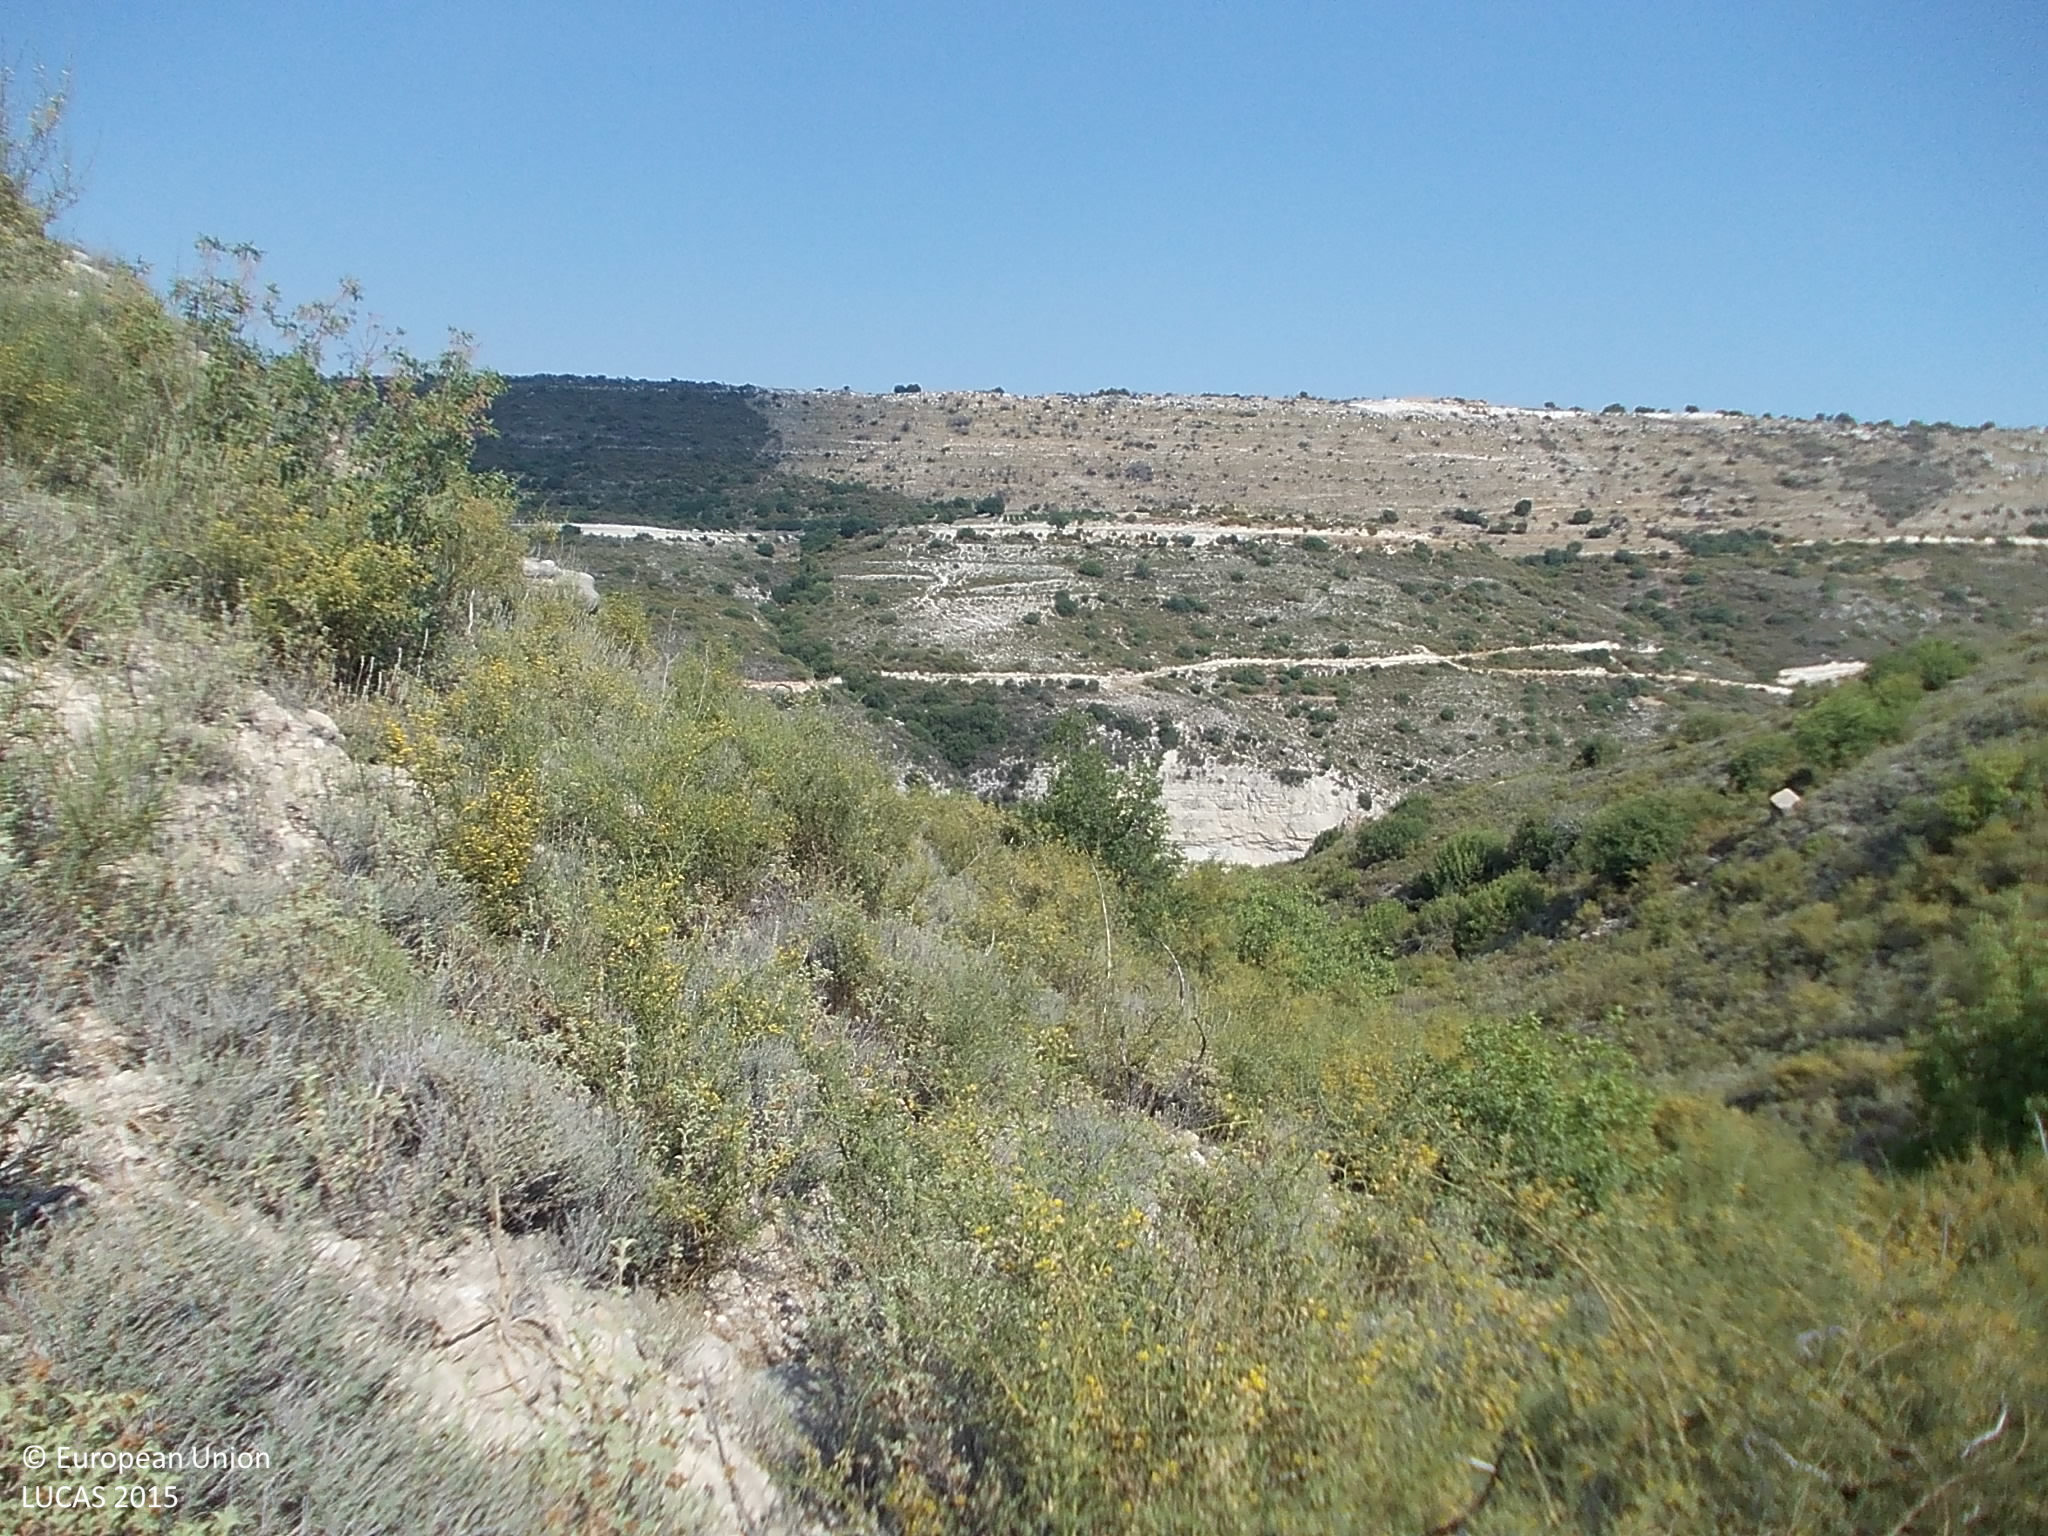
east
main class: Shrubland
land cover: Shrubland without tree cover
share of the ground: > 75 %
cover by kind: shrubs 80 %, herbaceous plants 10 %, unconsolidated bare surface 10 %
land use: Semi-natural and natural areas not in use
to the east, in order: Shrubland without tree cover; Paved roads, cycling and walking lanes; Shrubland without tree cover
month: July
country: CY
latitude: 34.7664
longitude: 32.7397
